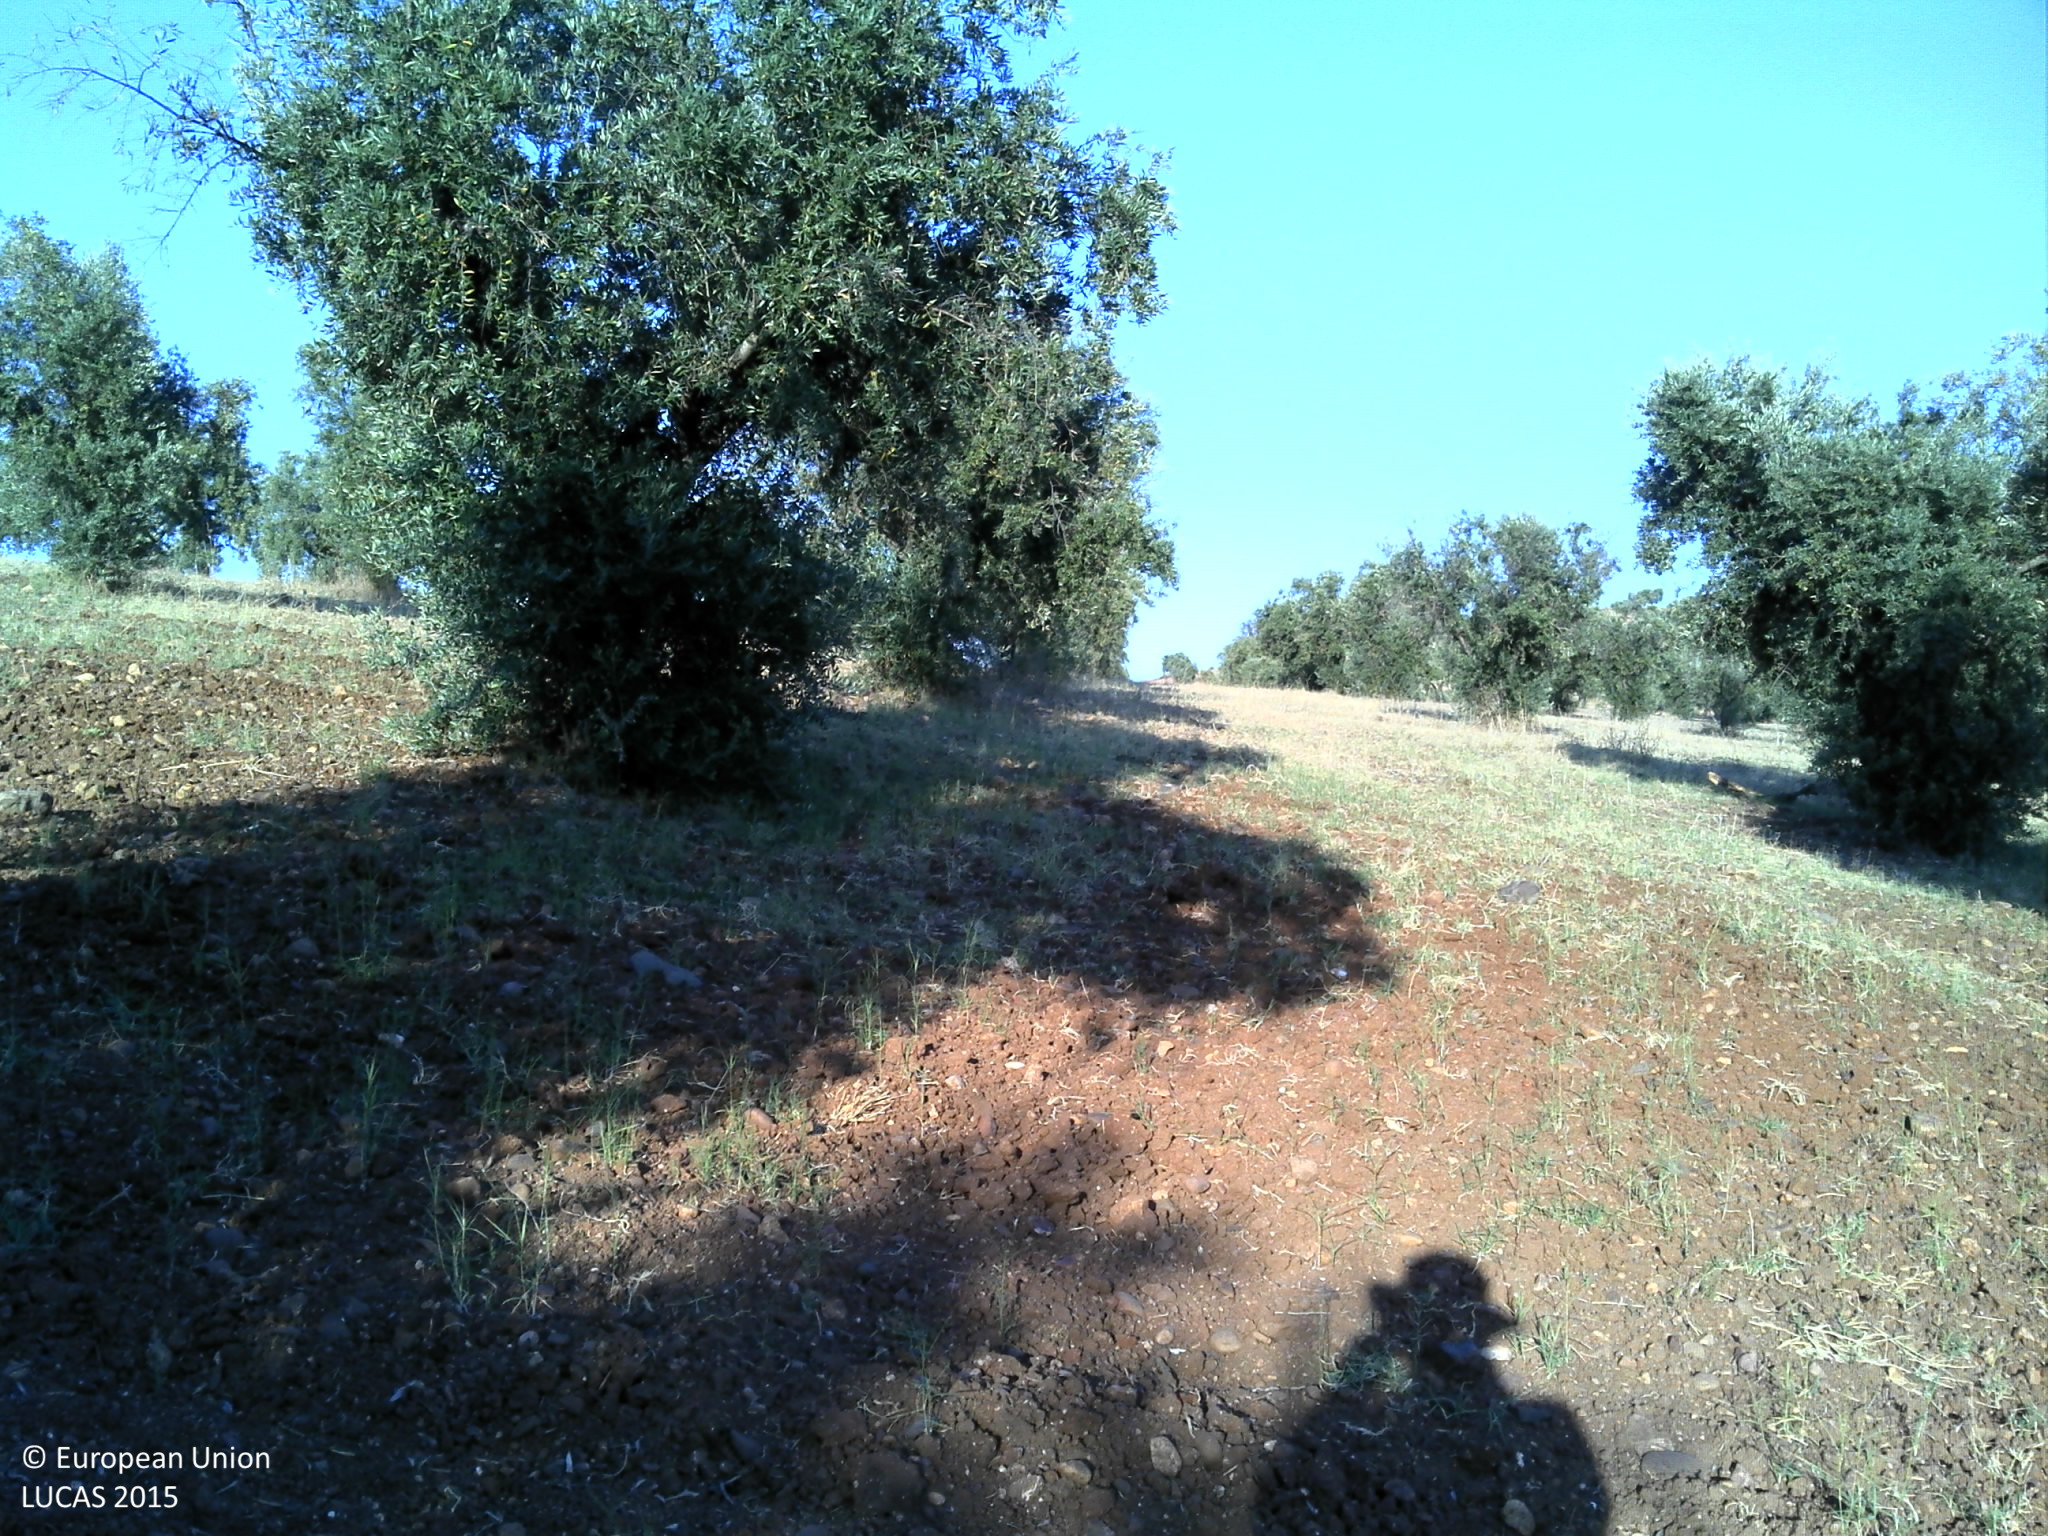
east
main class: Cropland
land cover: Olive groves
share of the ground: 25 - 50 %
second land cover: Grassland without tree/shrub cover
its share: 10 - 25 %
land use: Agriculture (excluding fallow land and kitchen gardens)
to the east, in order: Olive groves; Grassland without tree/shrub cover; Olive groves
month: June
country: PT
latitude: 38.1258
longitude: -7.6028
